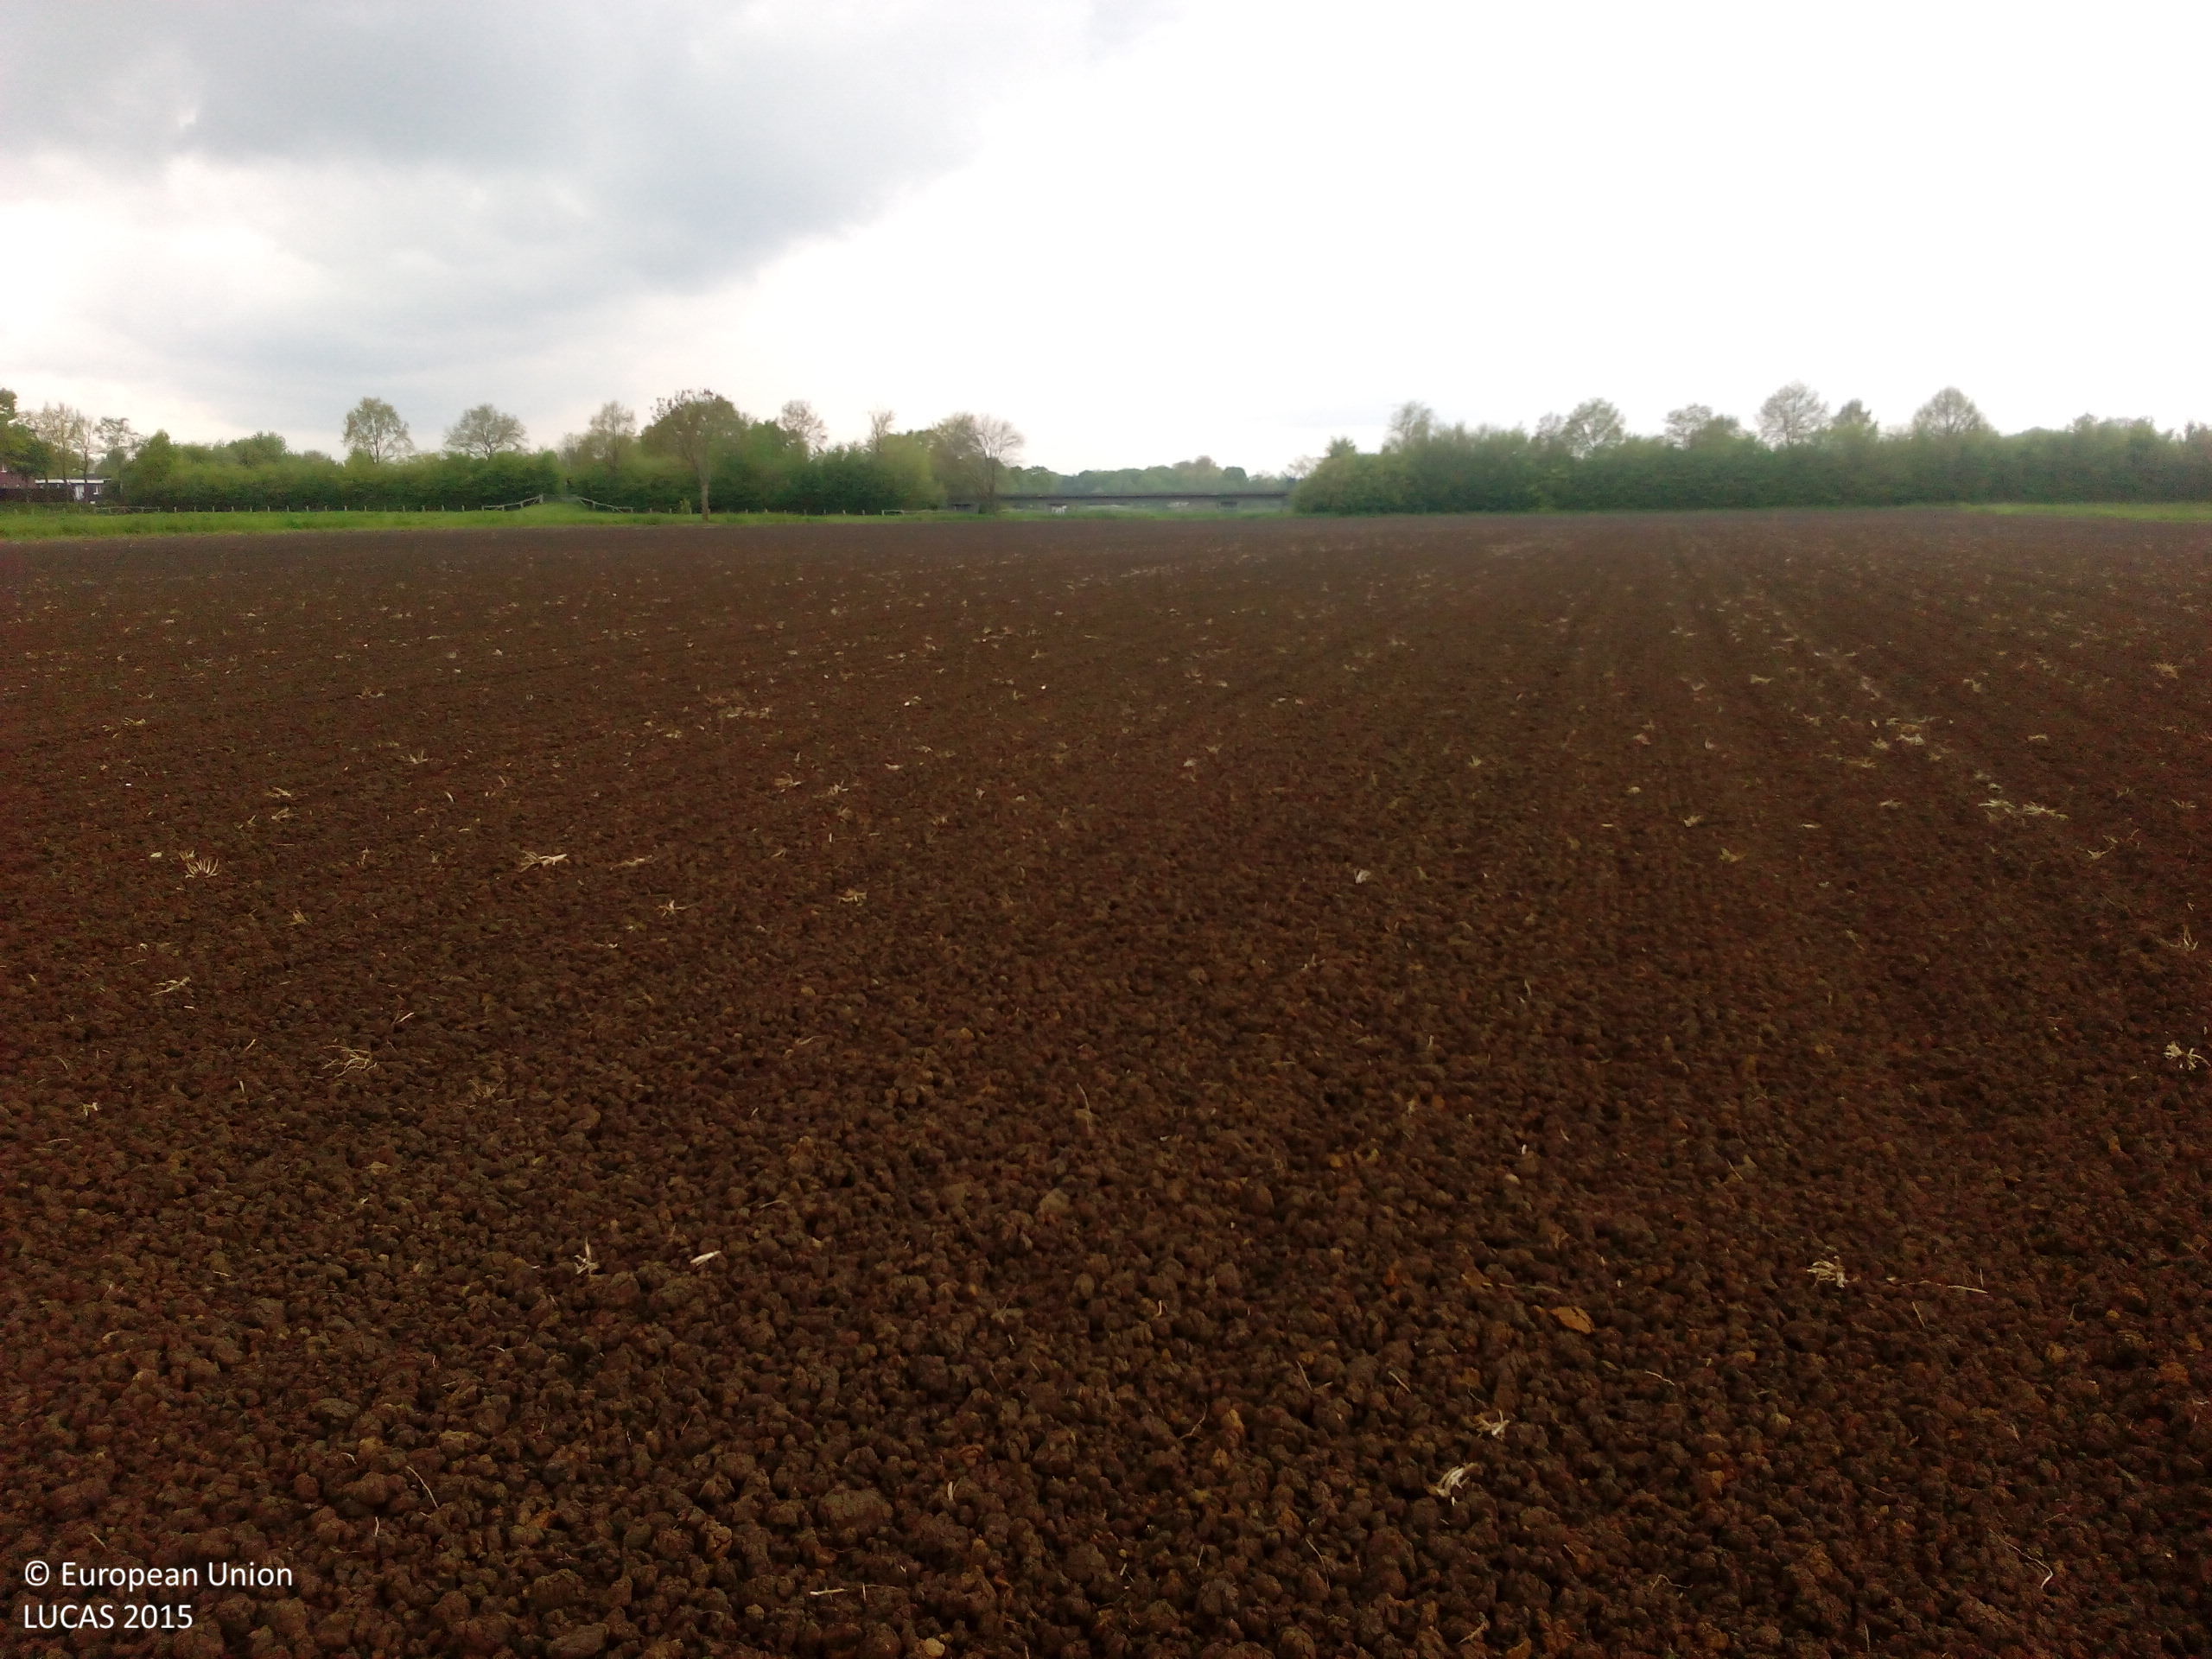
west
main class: Cropland
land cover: Maize
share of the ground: < 10 %
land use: Agriculture (excluding fallow land and kitchen gardens)
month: May
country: DE
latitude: 51.7191
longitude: 7.3802
